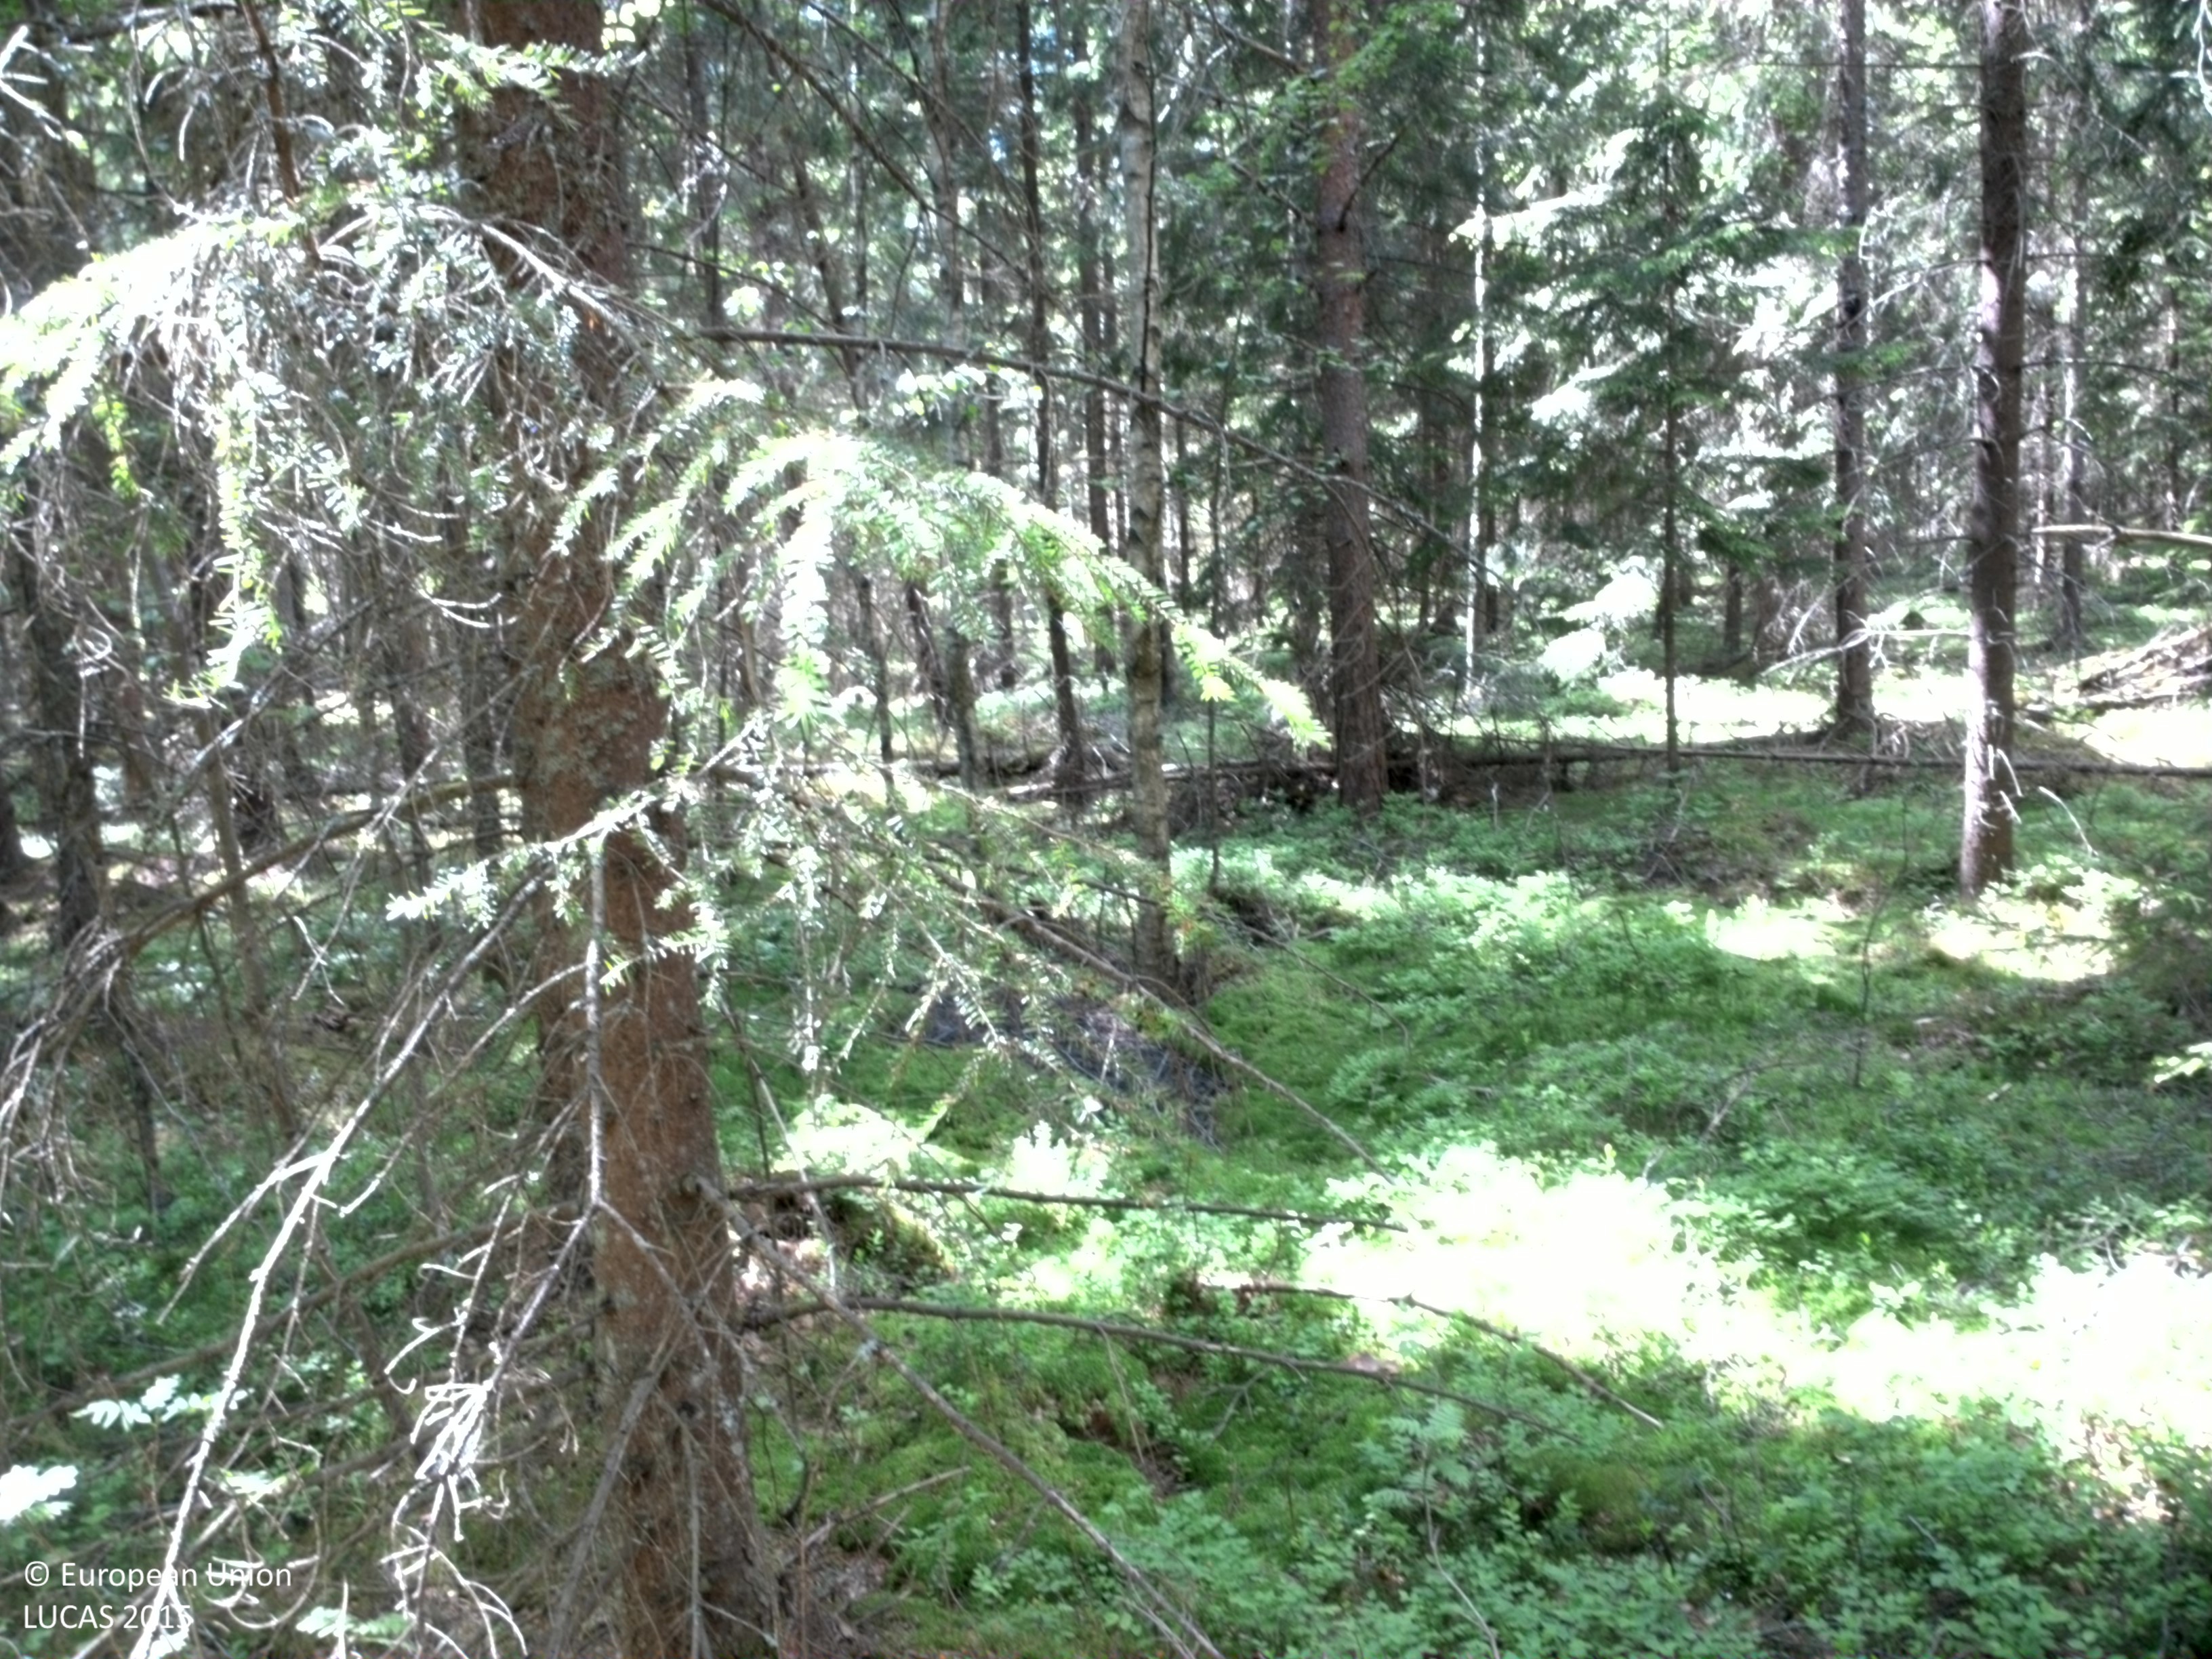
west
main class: Woodland
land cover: Spruce dominated mixed woodland
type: boreal forest
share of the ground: > 75 %
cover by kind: coniferous forest trees 65 %, broadleaved forest trees 25 %, shrubs 10 %
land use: Forestry
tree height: > 5 m
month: June
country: SE
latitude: 59.2273
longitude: 13.1296
